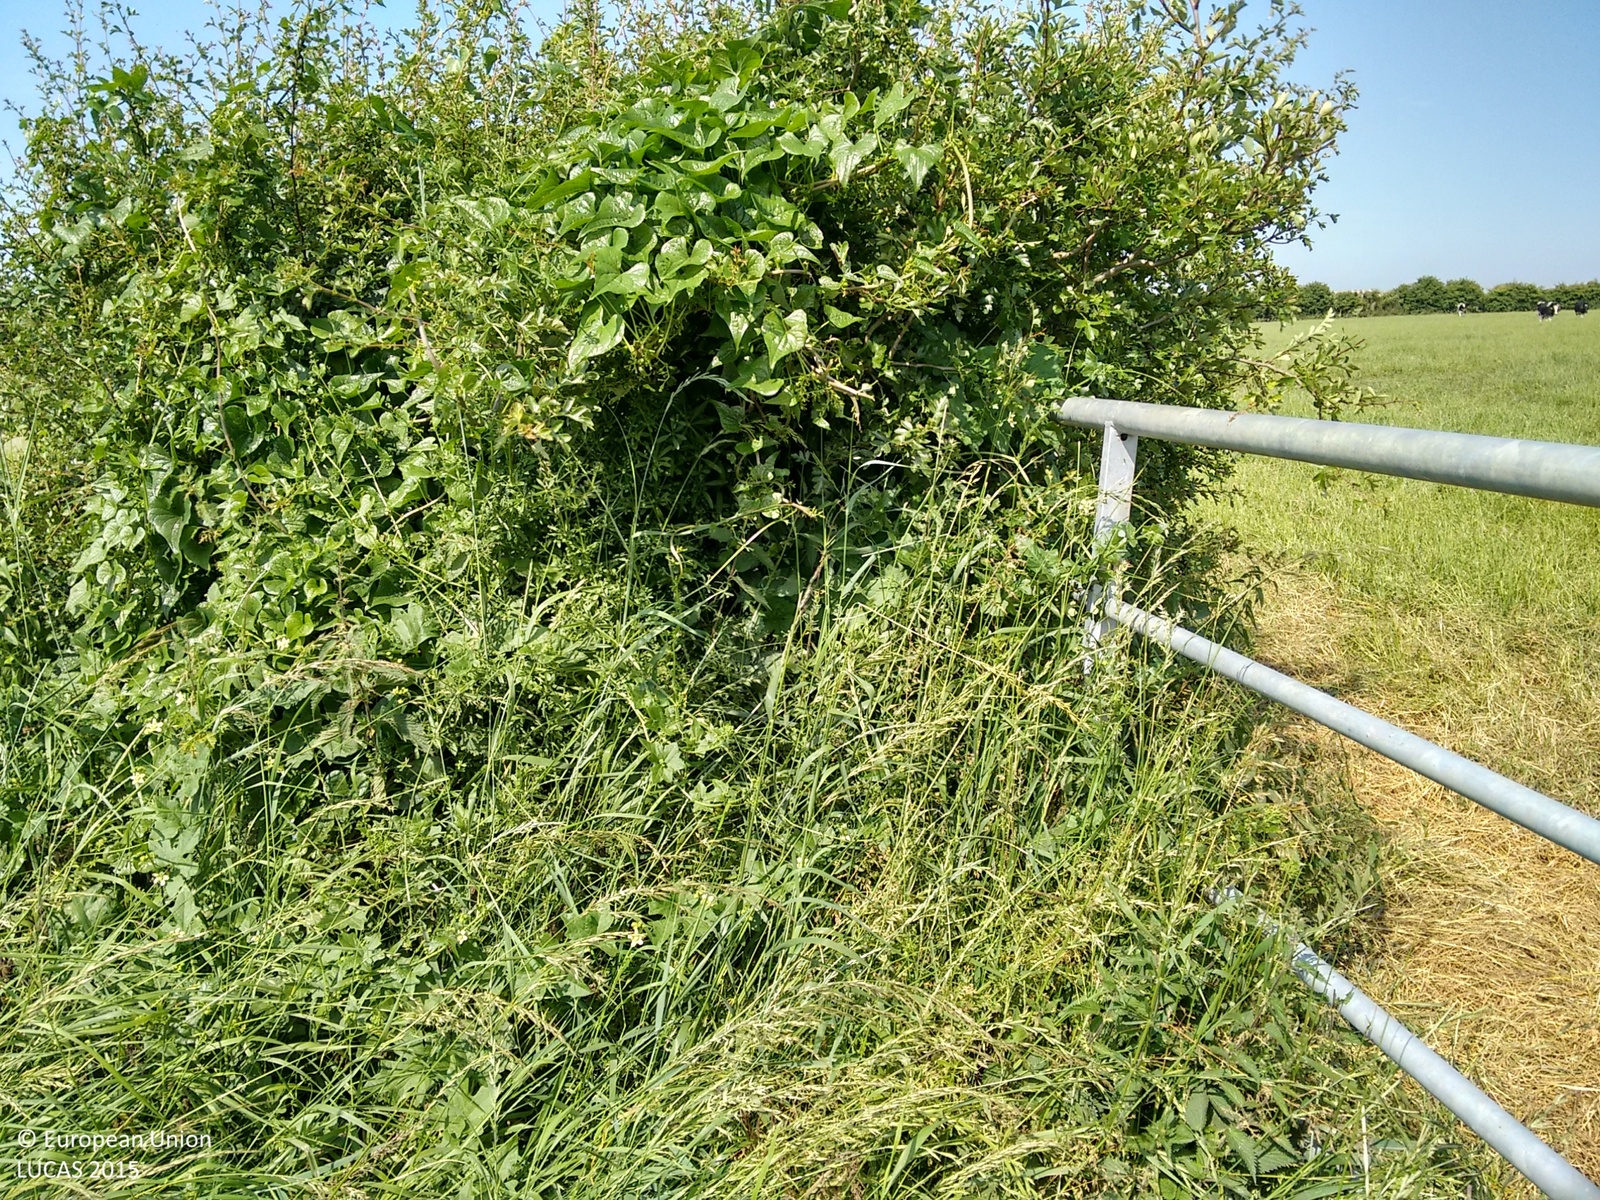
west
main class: Grassland
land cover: Grassland without tree/shrub cover
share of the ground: > 75 %
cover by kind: herbaceous plants 100 %
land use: Agriculture (excluding fallow land and kitchen gardens)
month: July
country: GB
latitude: 53.4005
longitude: -0.6728
